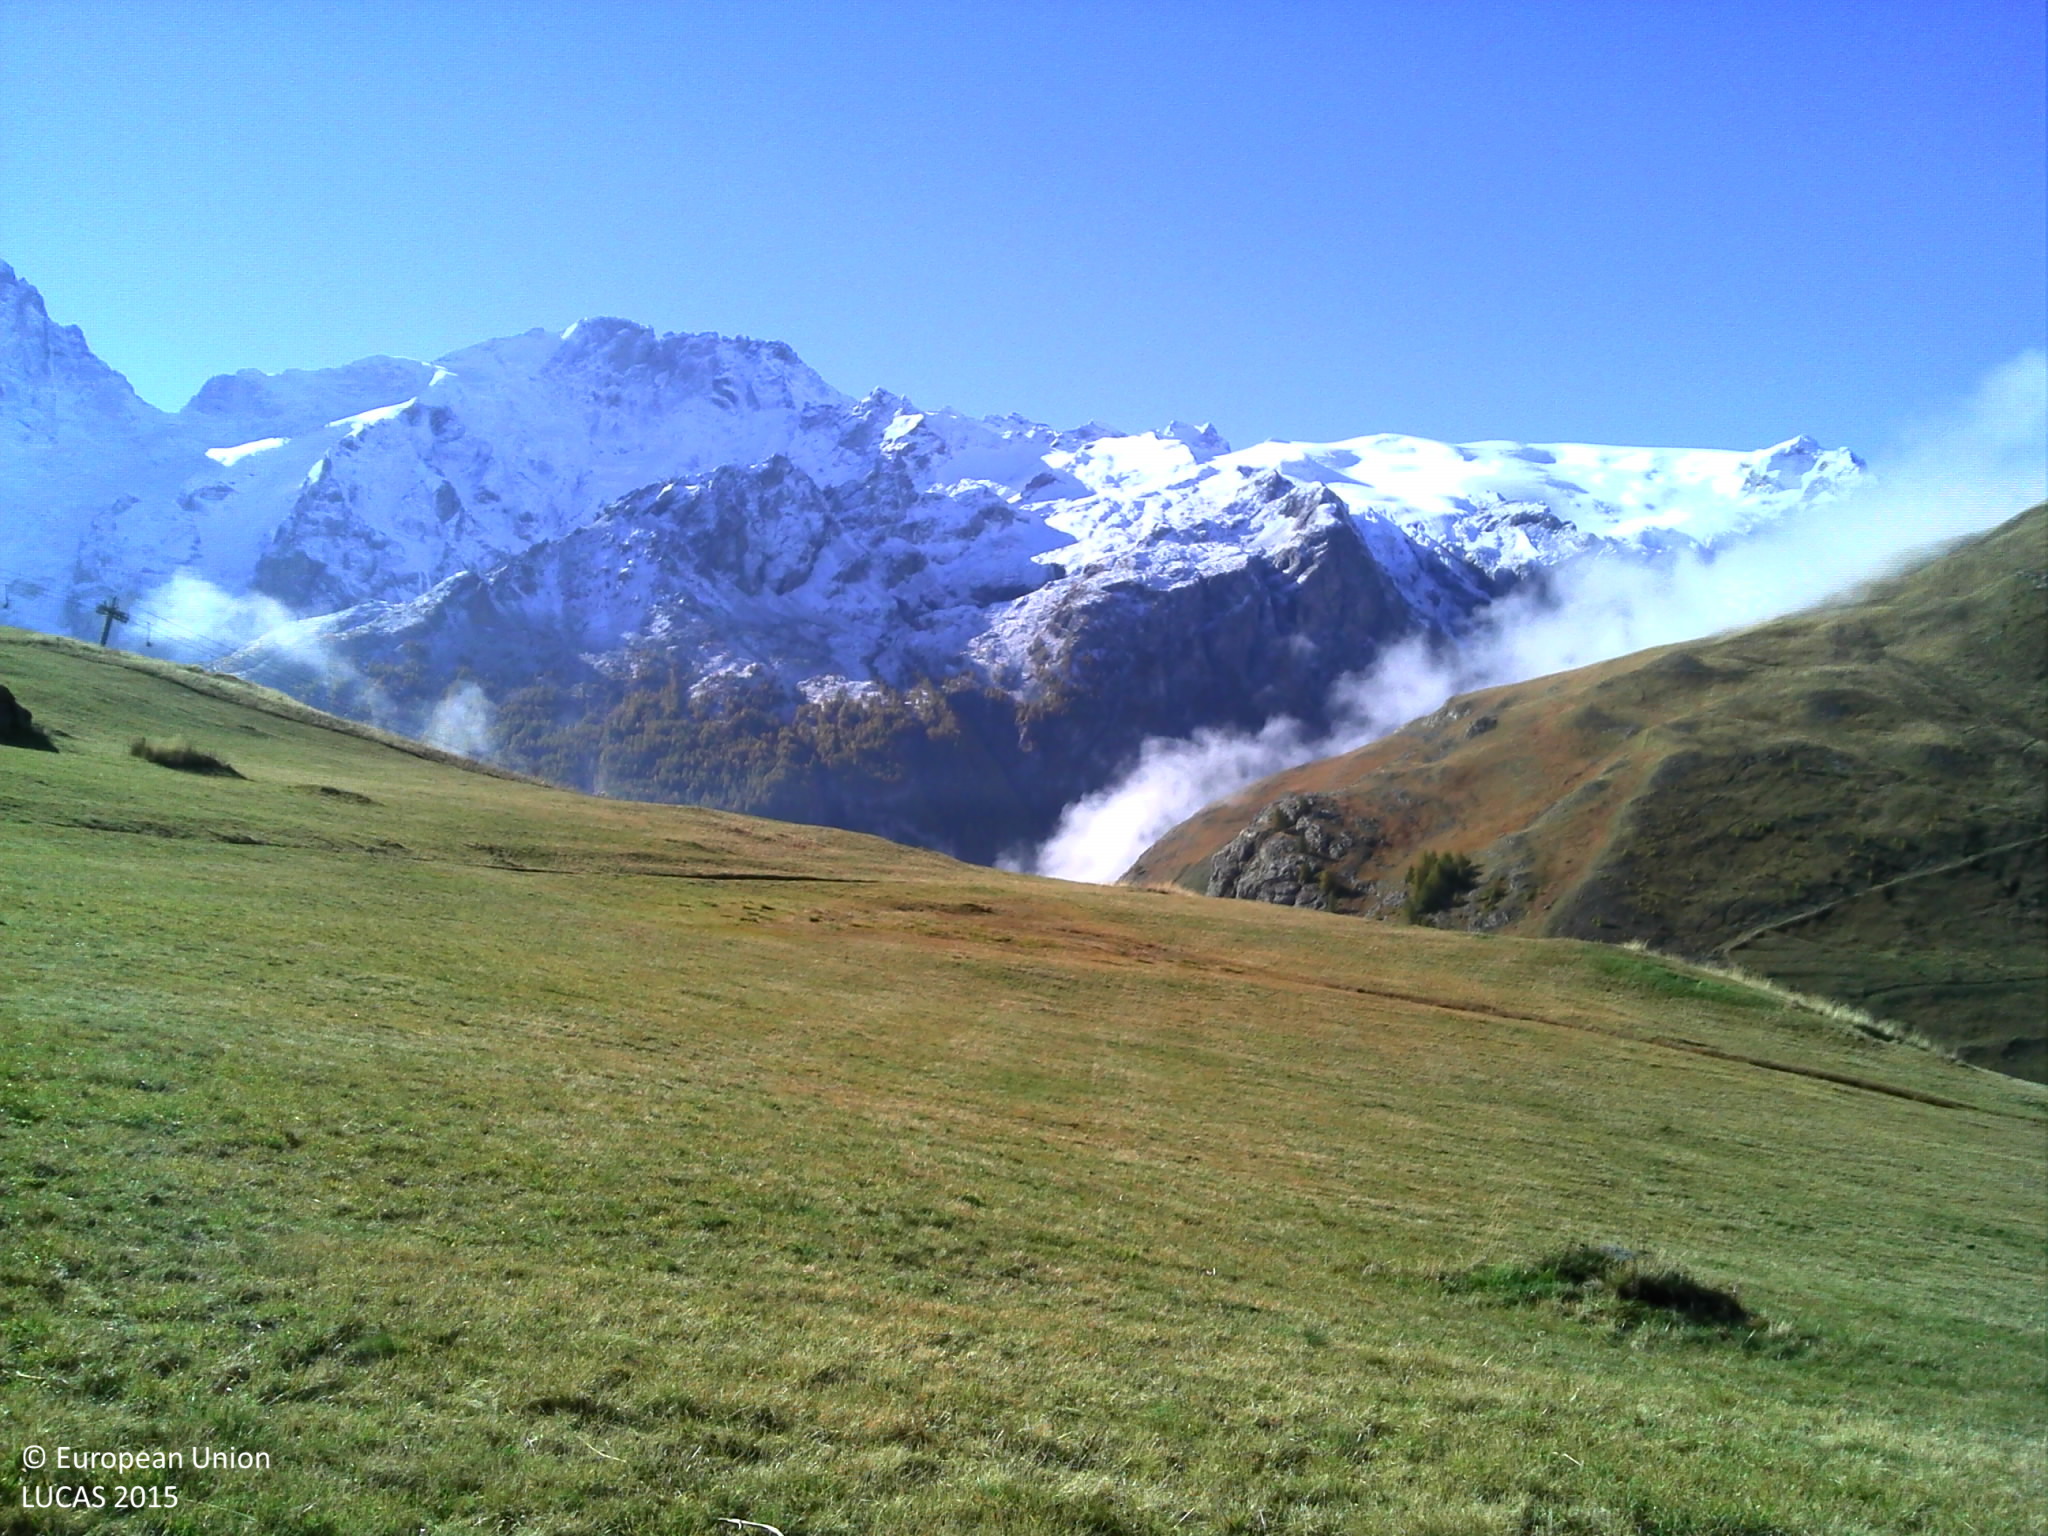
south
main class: Grassland
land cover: Grassland without tree/shrub cover
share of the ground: > 75 %
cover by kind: herbaceous plants 95 %, unconsolidated bare surface 5 %
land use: Agriculture (excluding fallow land and kitchen gardens)
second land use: Sport
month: October
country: FR
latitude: 45.0602
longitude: 6.2846
